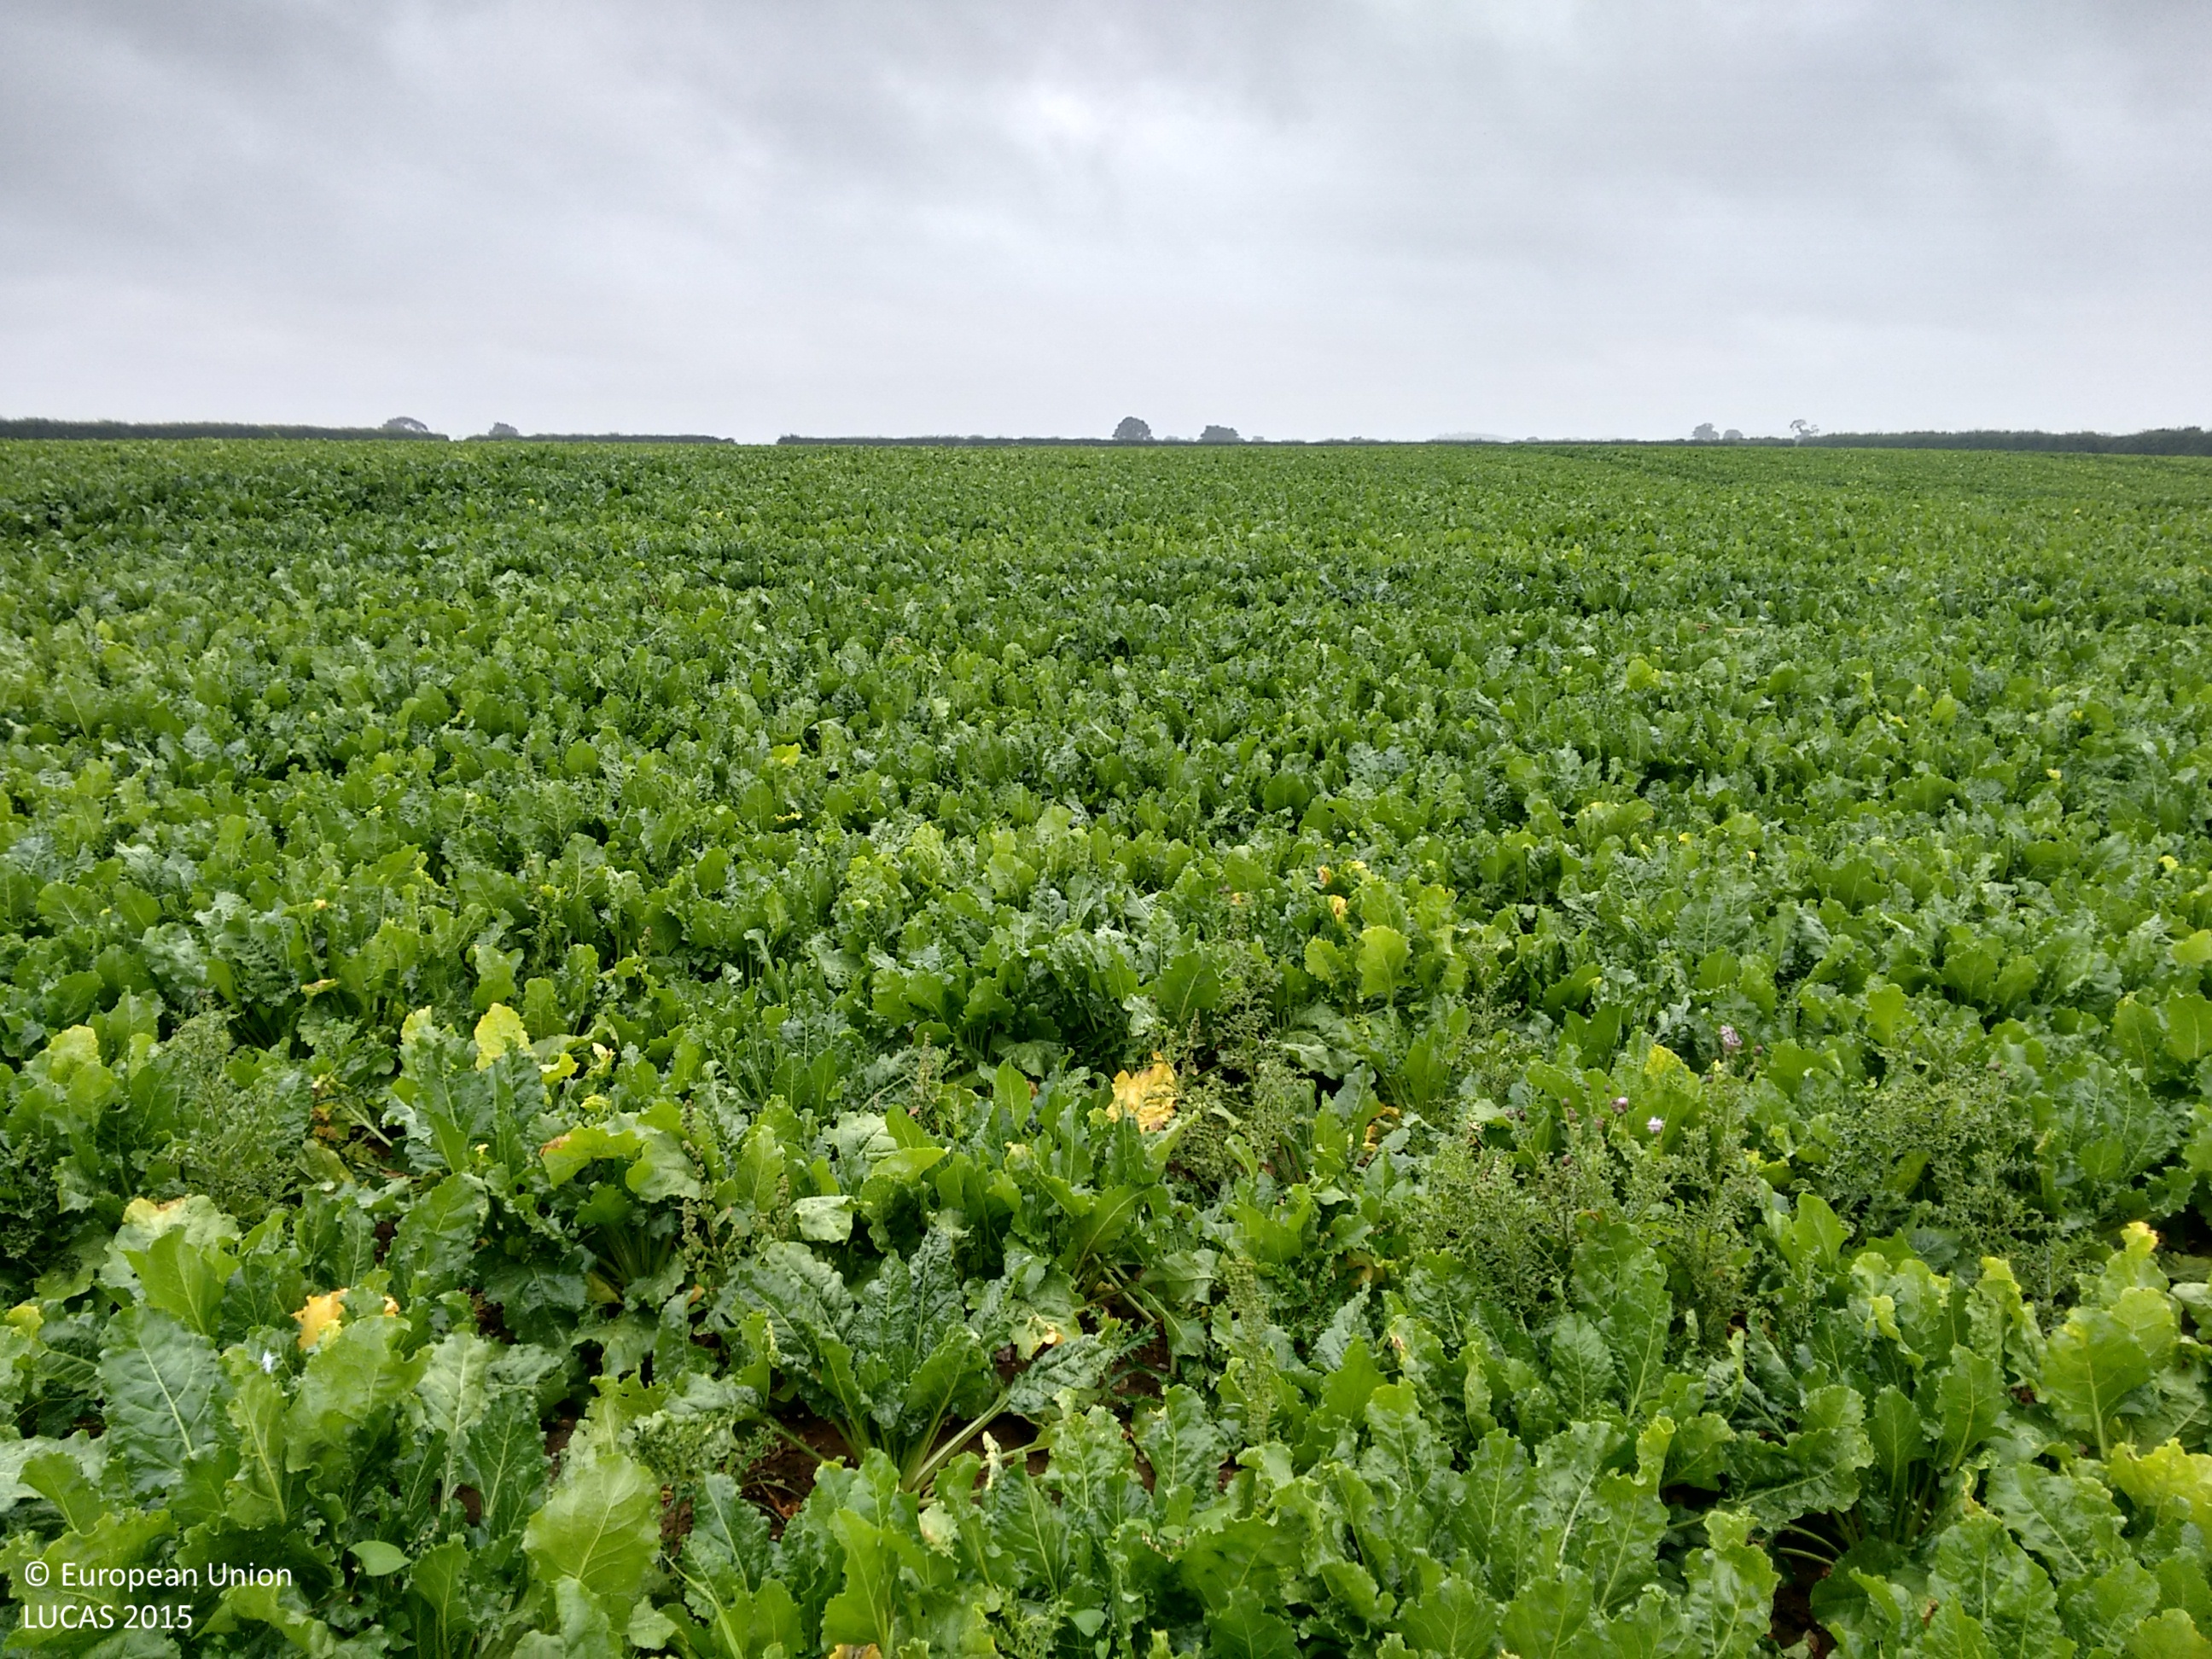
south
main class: Cropland
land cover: Sugar beet
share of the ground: > 75 %
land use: Agriculture (excluding fallow land and kitchen gardens)
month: August
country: GB
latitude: 52.9065
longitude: 0.8017
